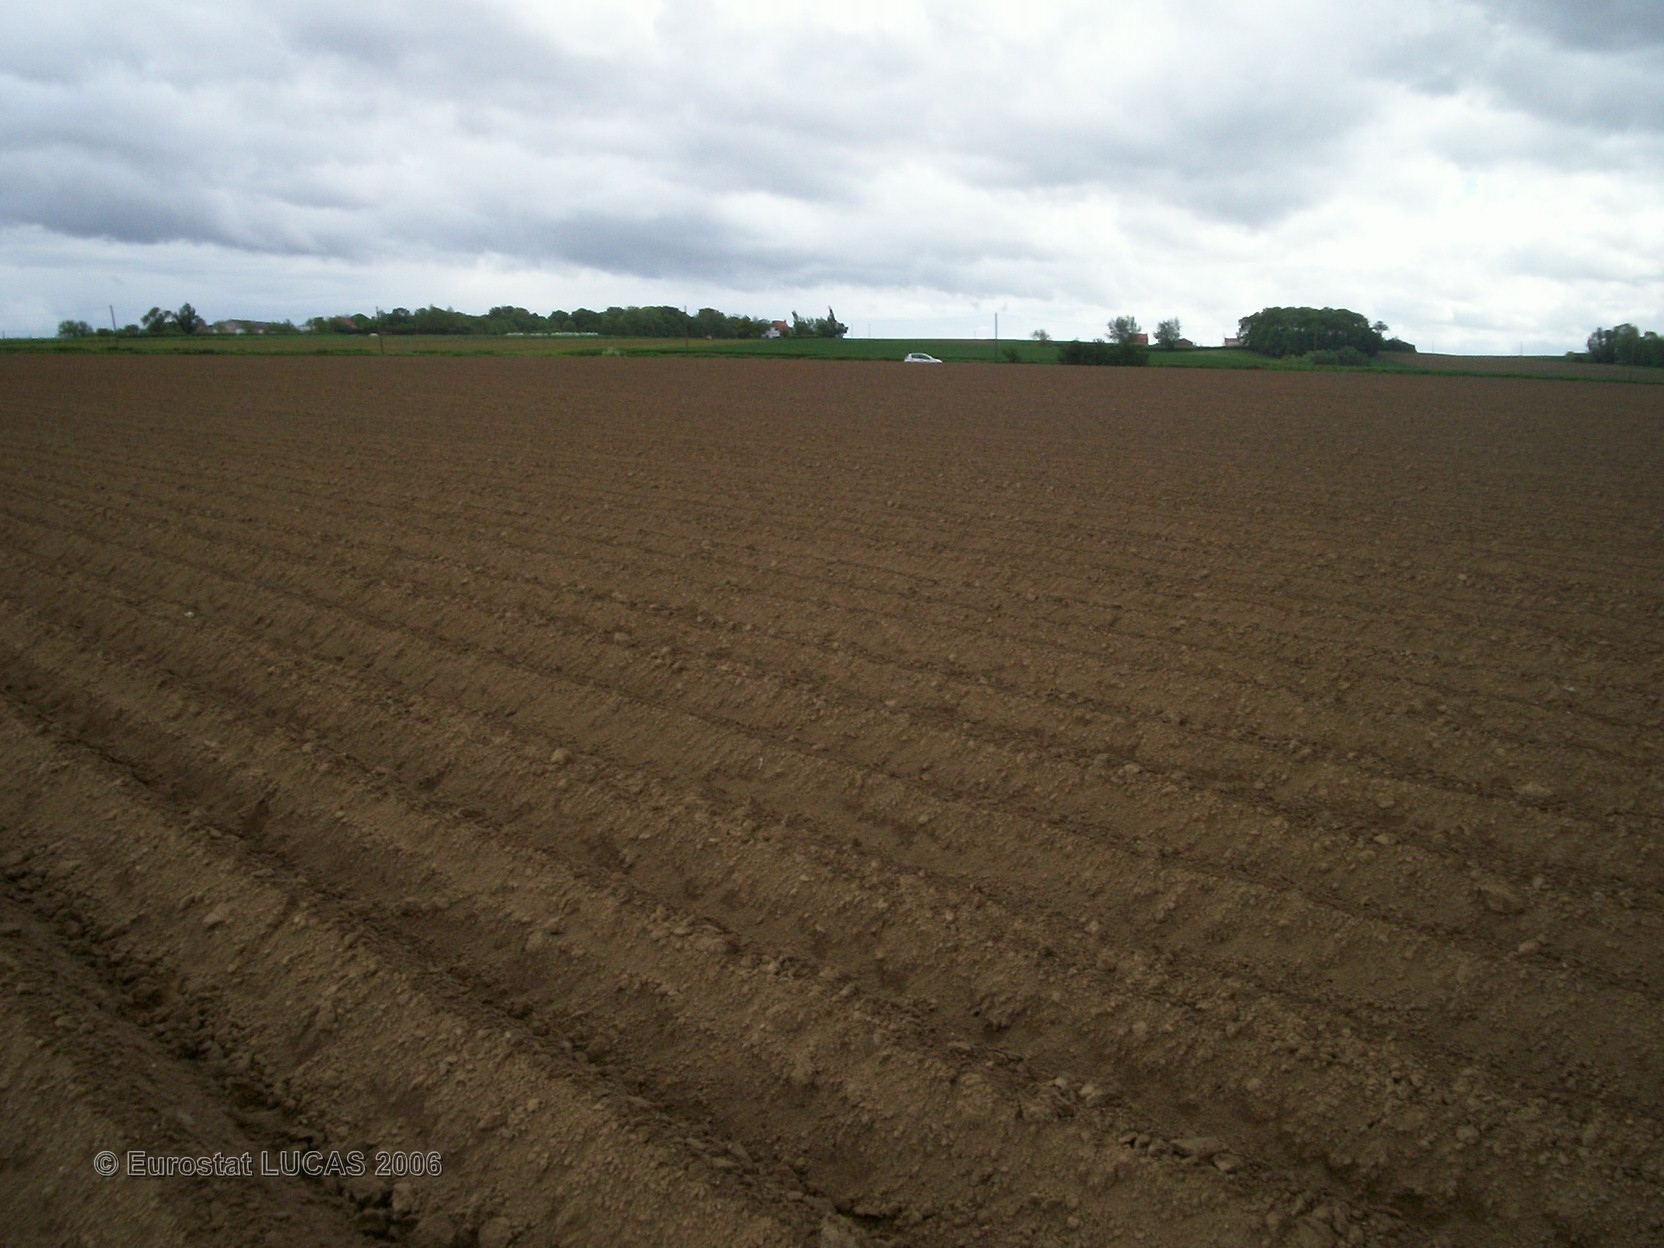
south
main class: Cropland
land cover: Potatoes
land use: Agriculture (excluding fallow land and kitchen gardens)
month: May
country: FR
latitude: 50.8168
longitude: 2.4215
